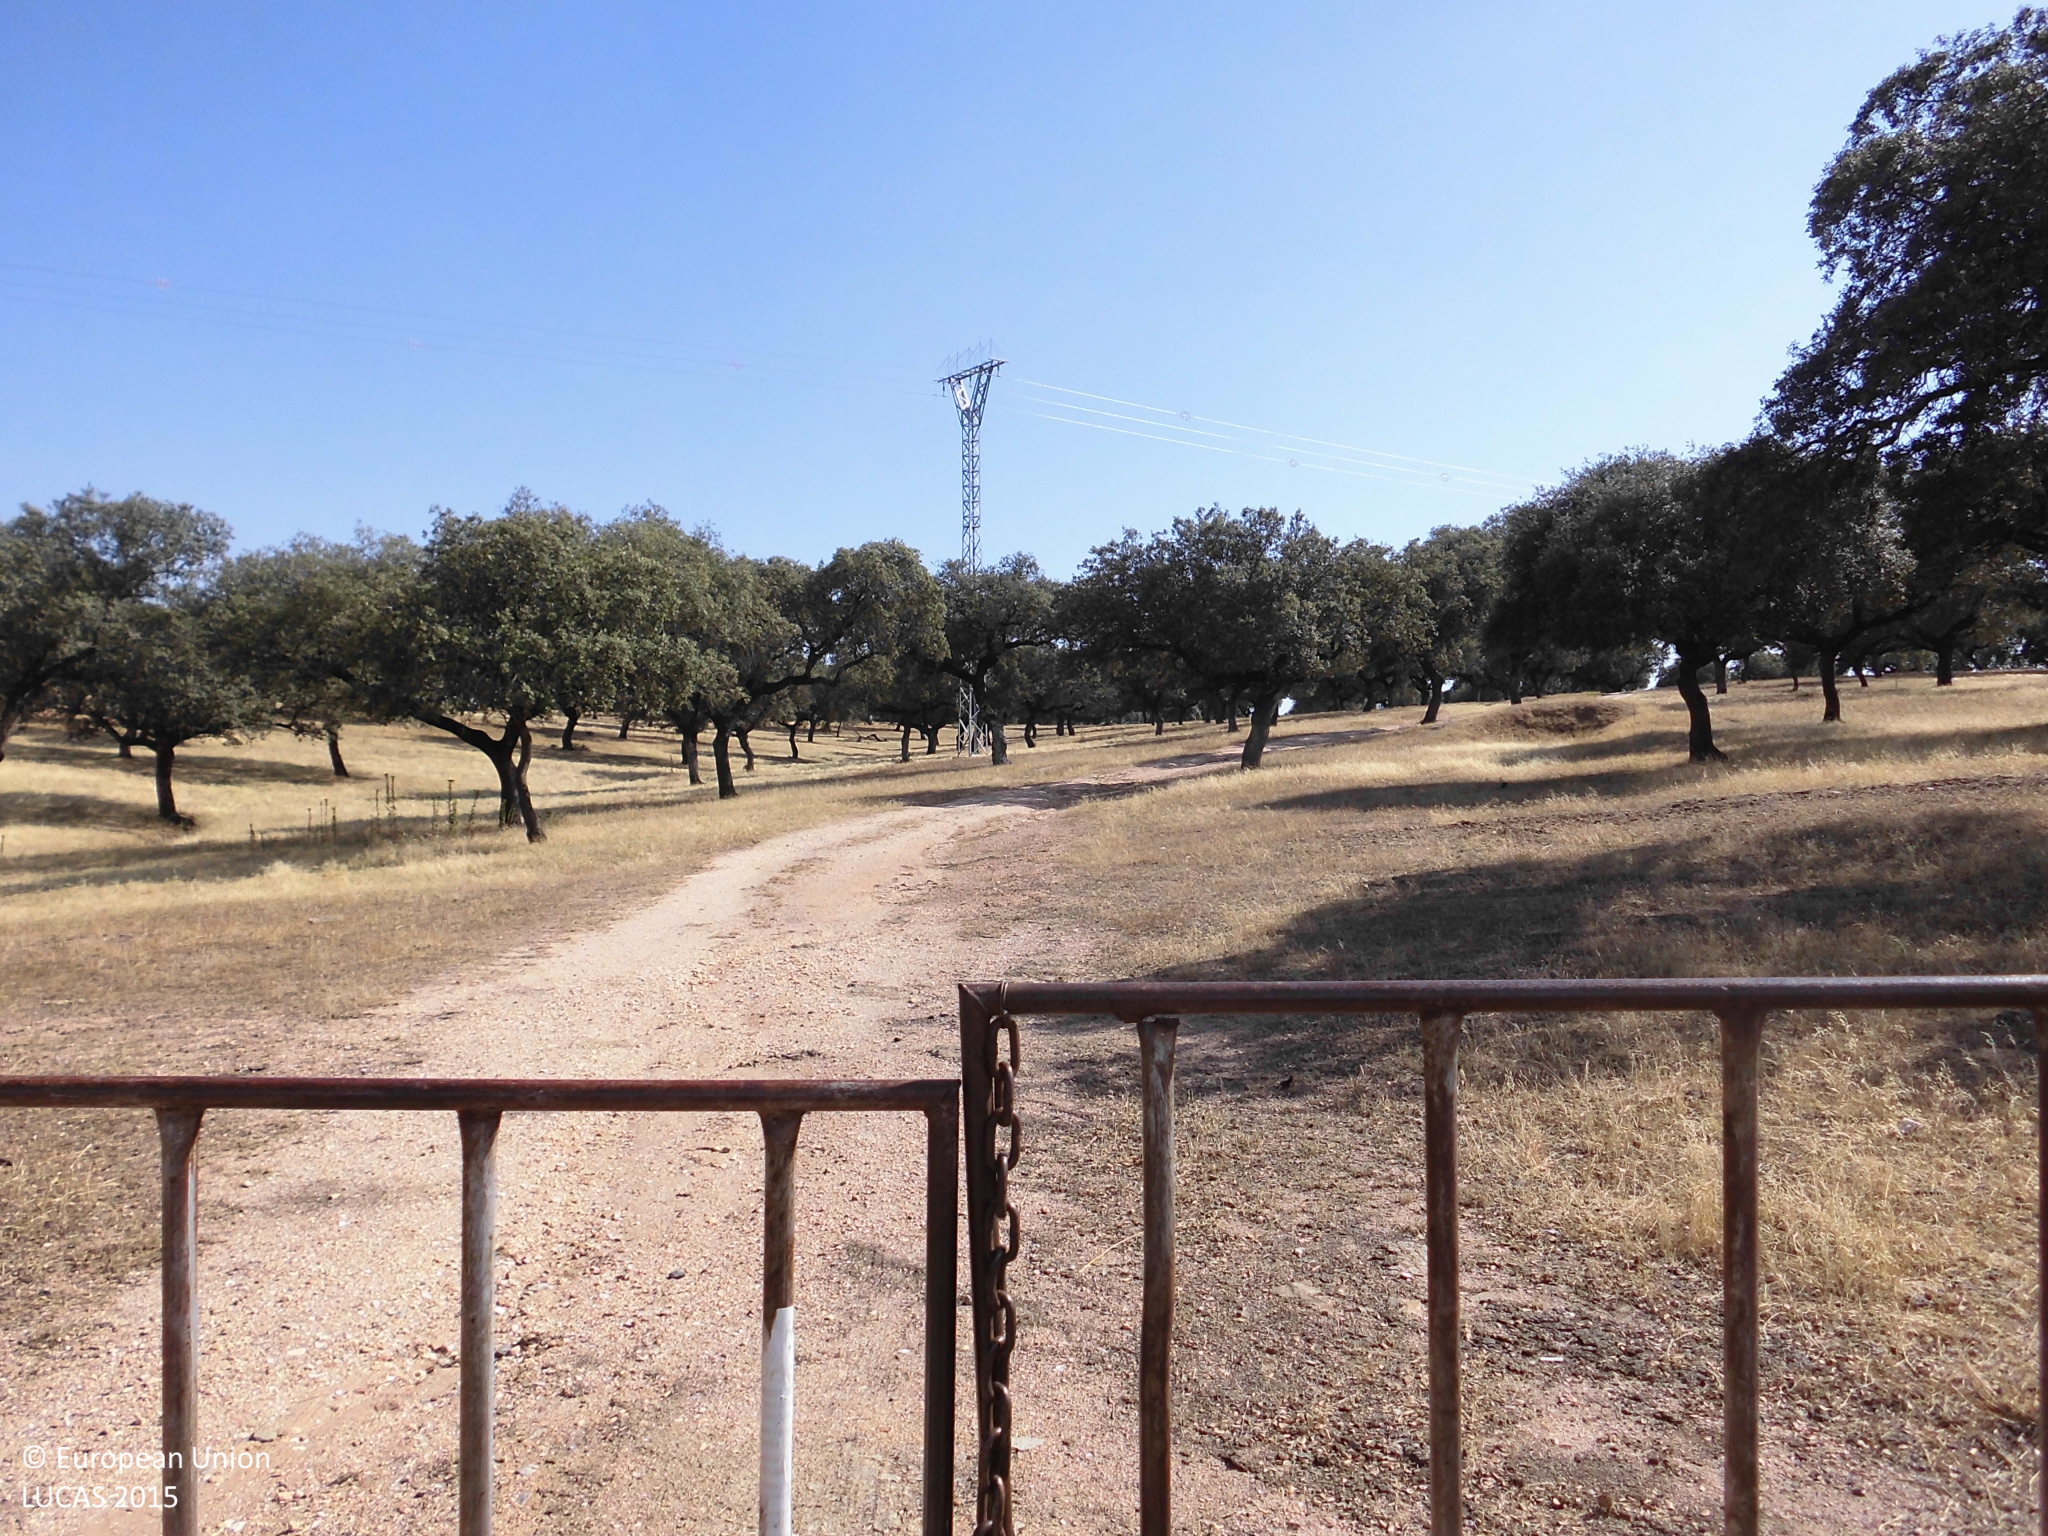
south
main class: Woodland
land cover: Broadleaved woodland
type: broadleaved evergreen forest
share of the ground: 25 - 50 %
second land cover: Grassland without tree/shrub cover
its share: > 75 %
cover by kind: herbaceous plants 70 %, broadleaved forest trees 30 %
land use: Forestry
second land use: Agriculture (excluding fallow land and kitchen gardens)
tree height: > 5 m
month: June
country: ES
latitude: 39.7434
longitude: -6.0656
